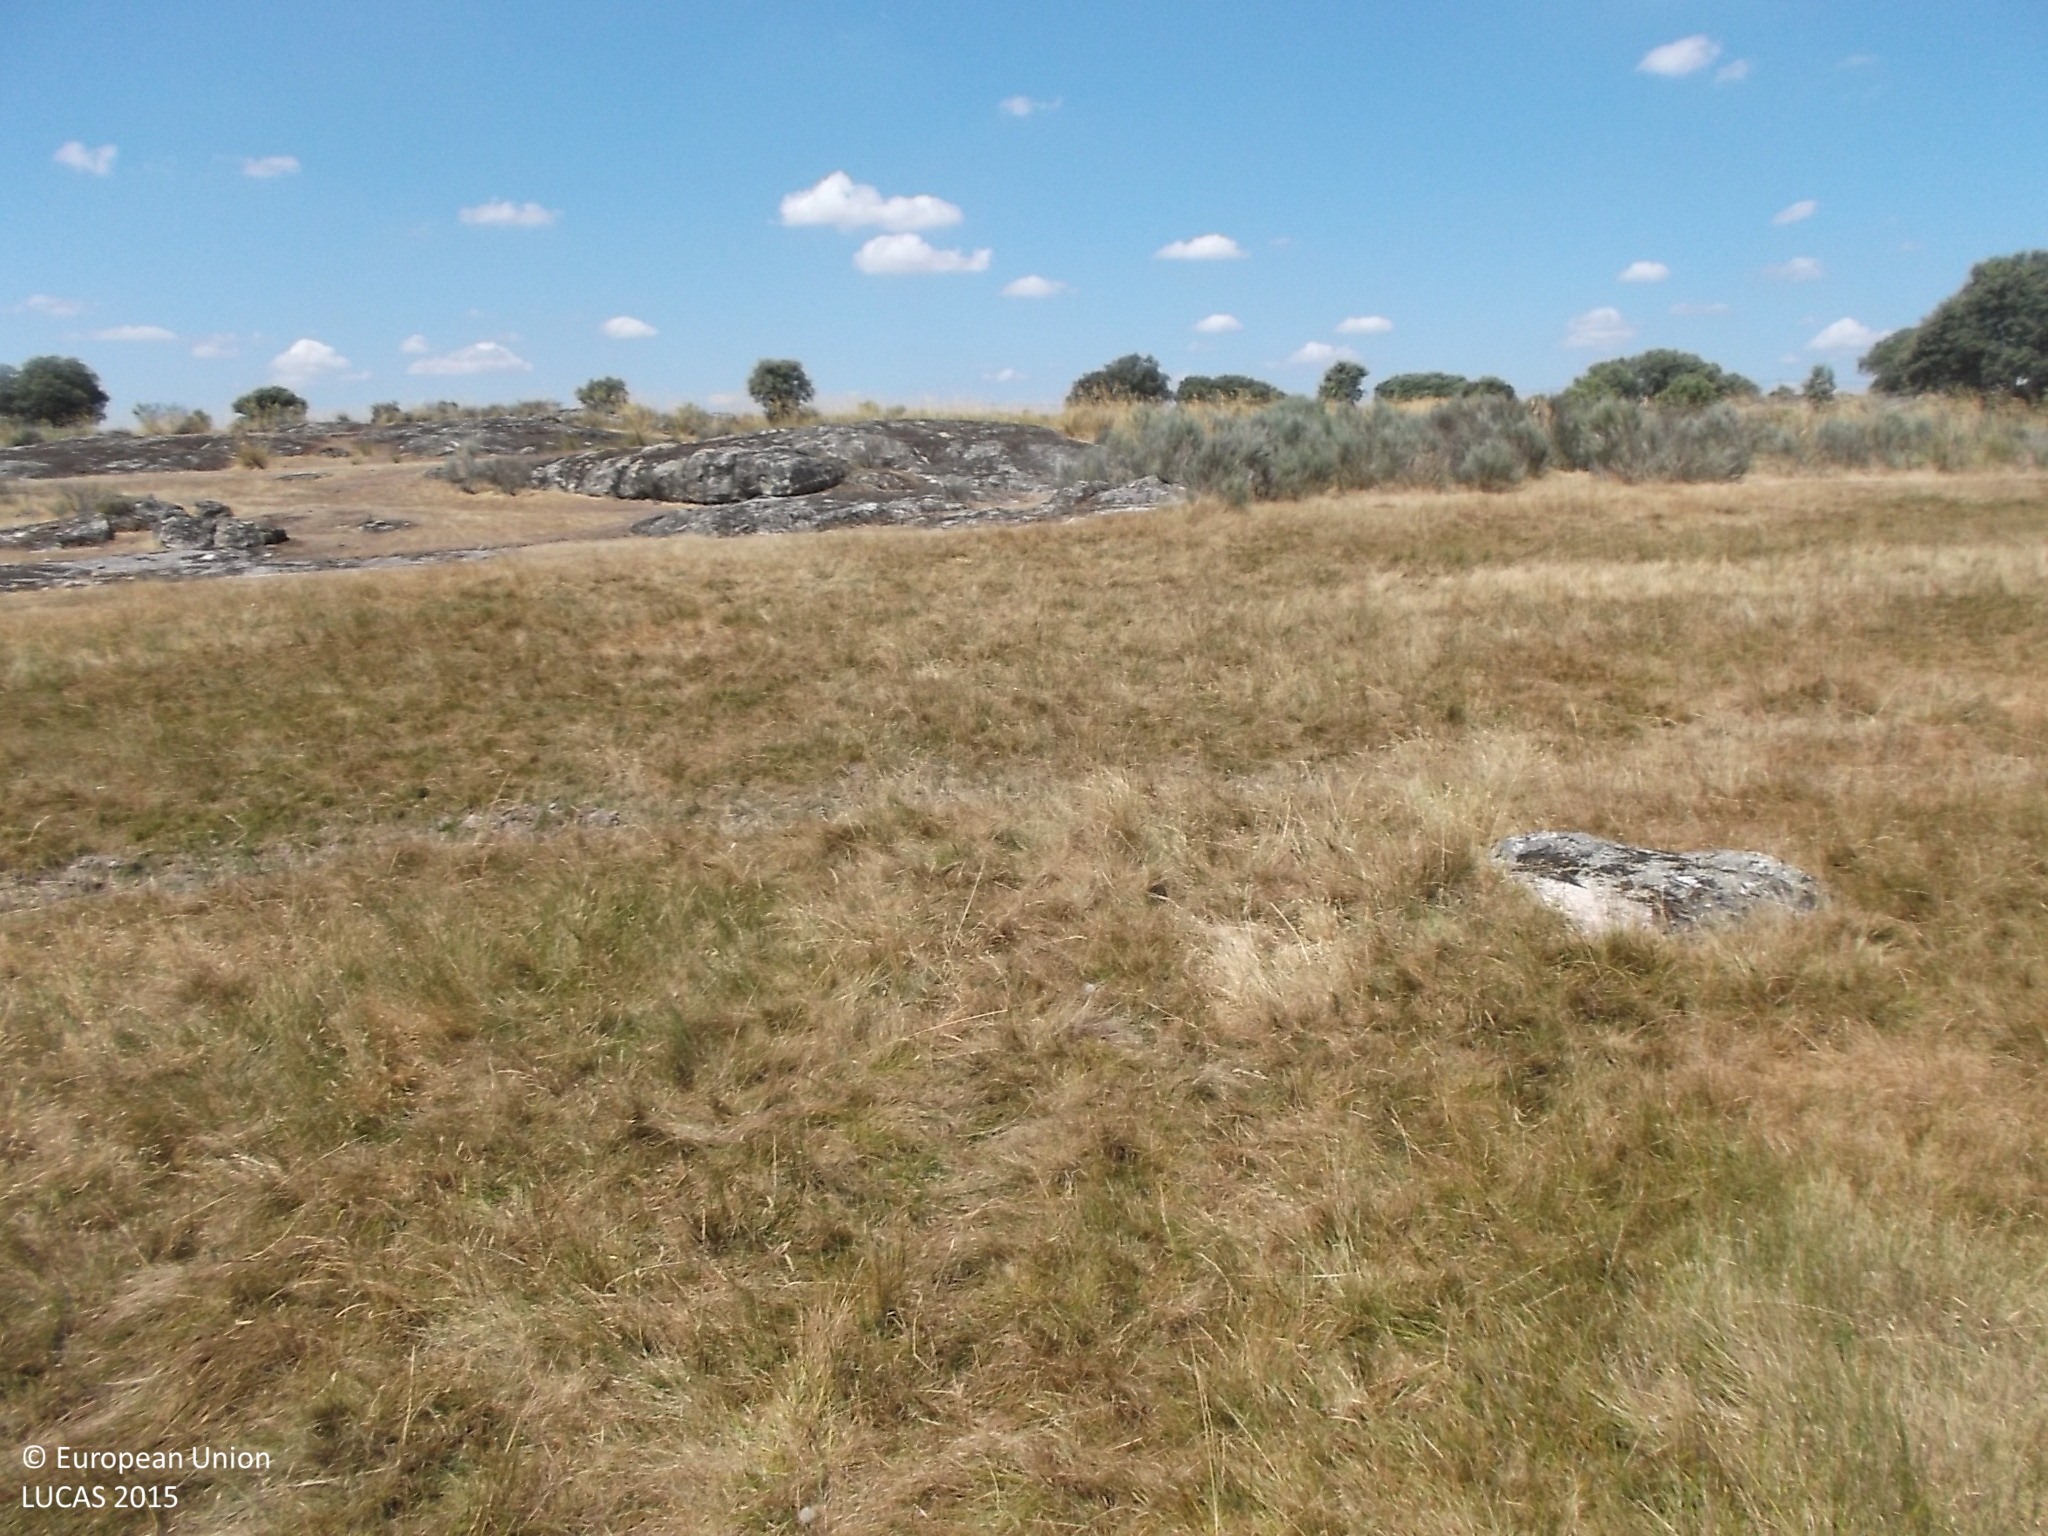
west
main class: Grassland
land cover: Grassland without tree/shrub cover
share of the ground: > 75 %
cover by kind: herbaceous plants 100 %
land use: Agriculture (excluding fallow land and kitchen gardens)
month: July
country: ES
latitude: 41.4210
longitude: -6.0407
